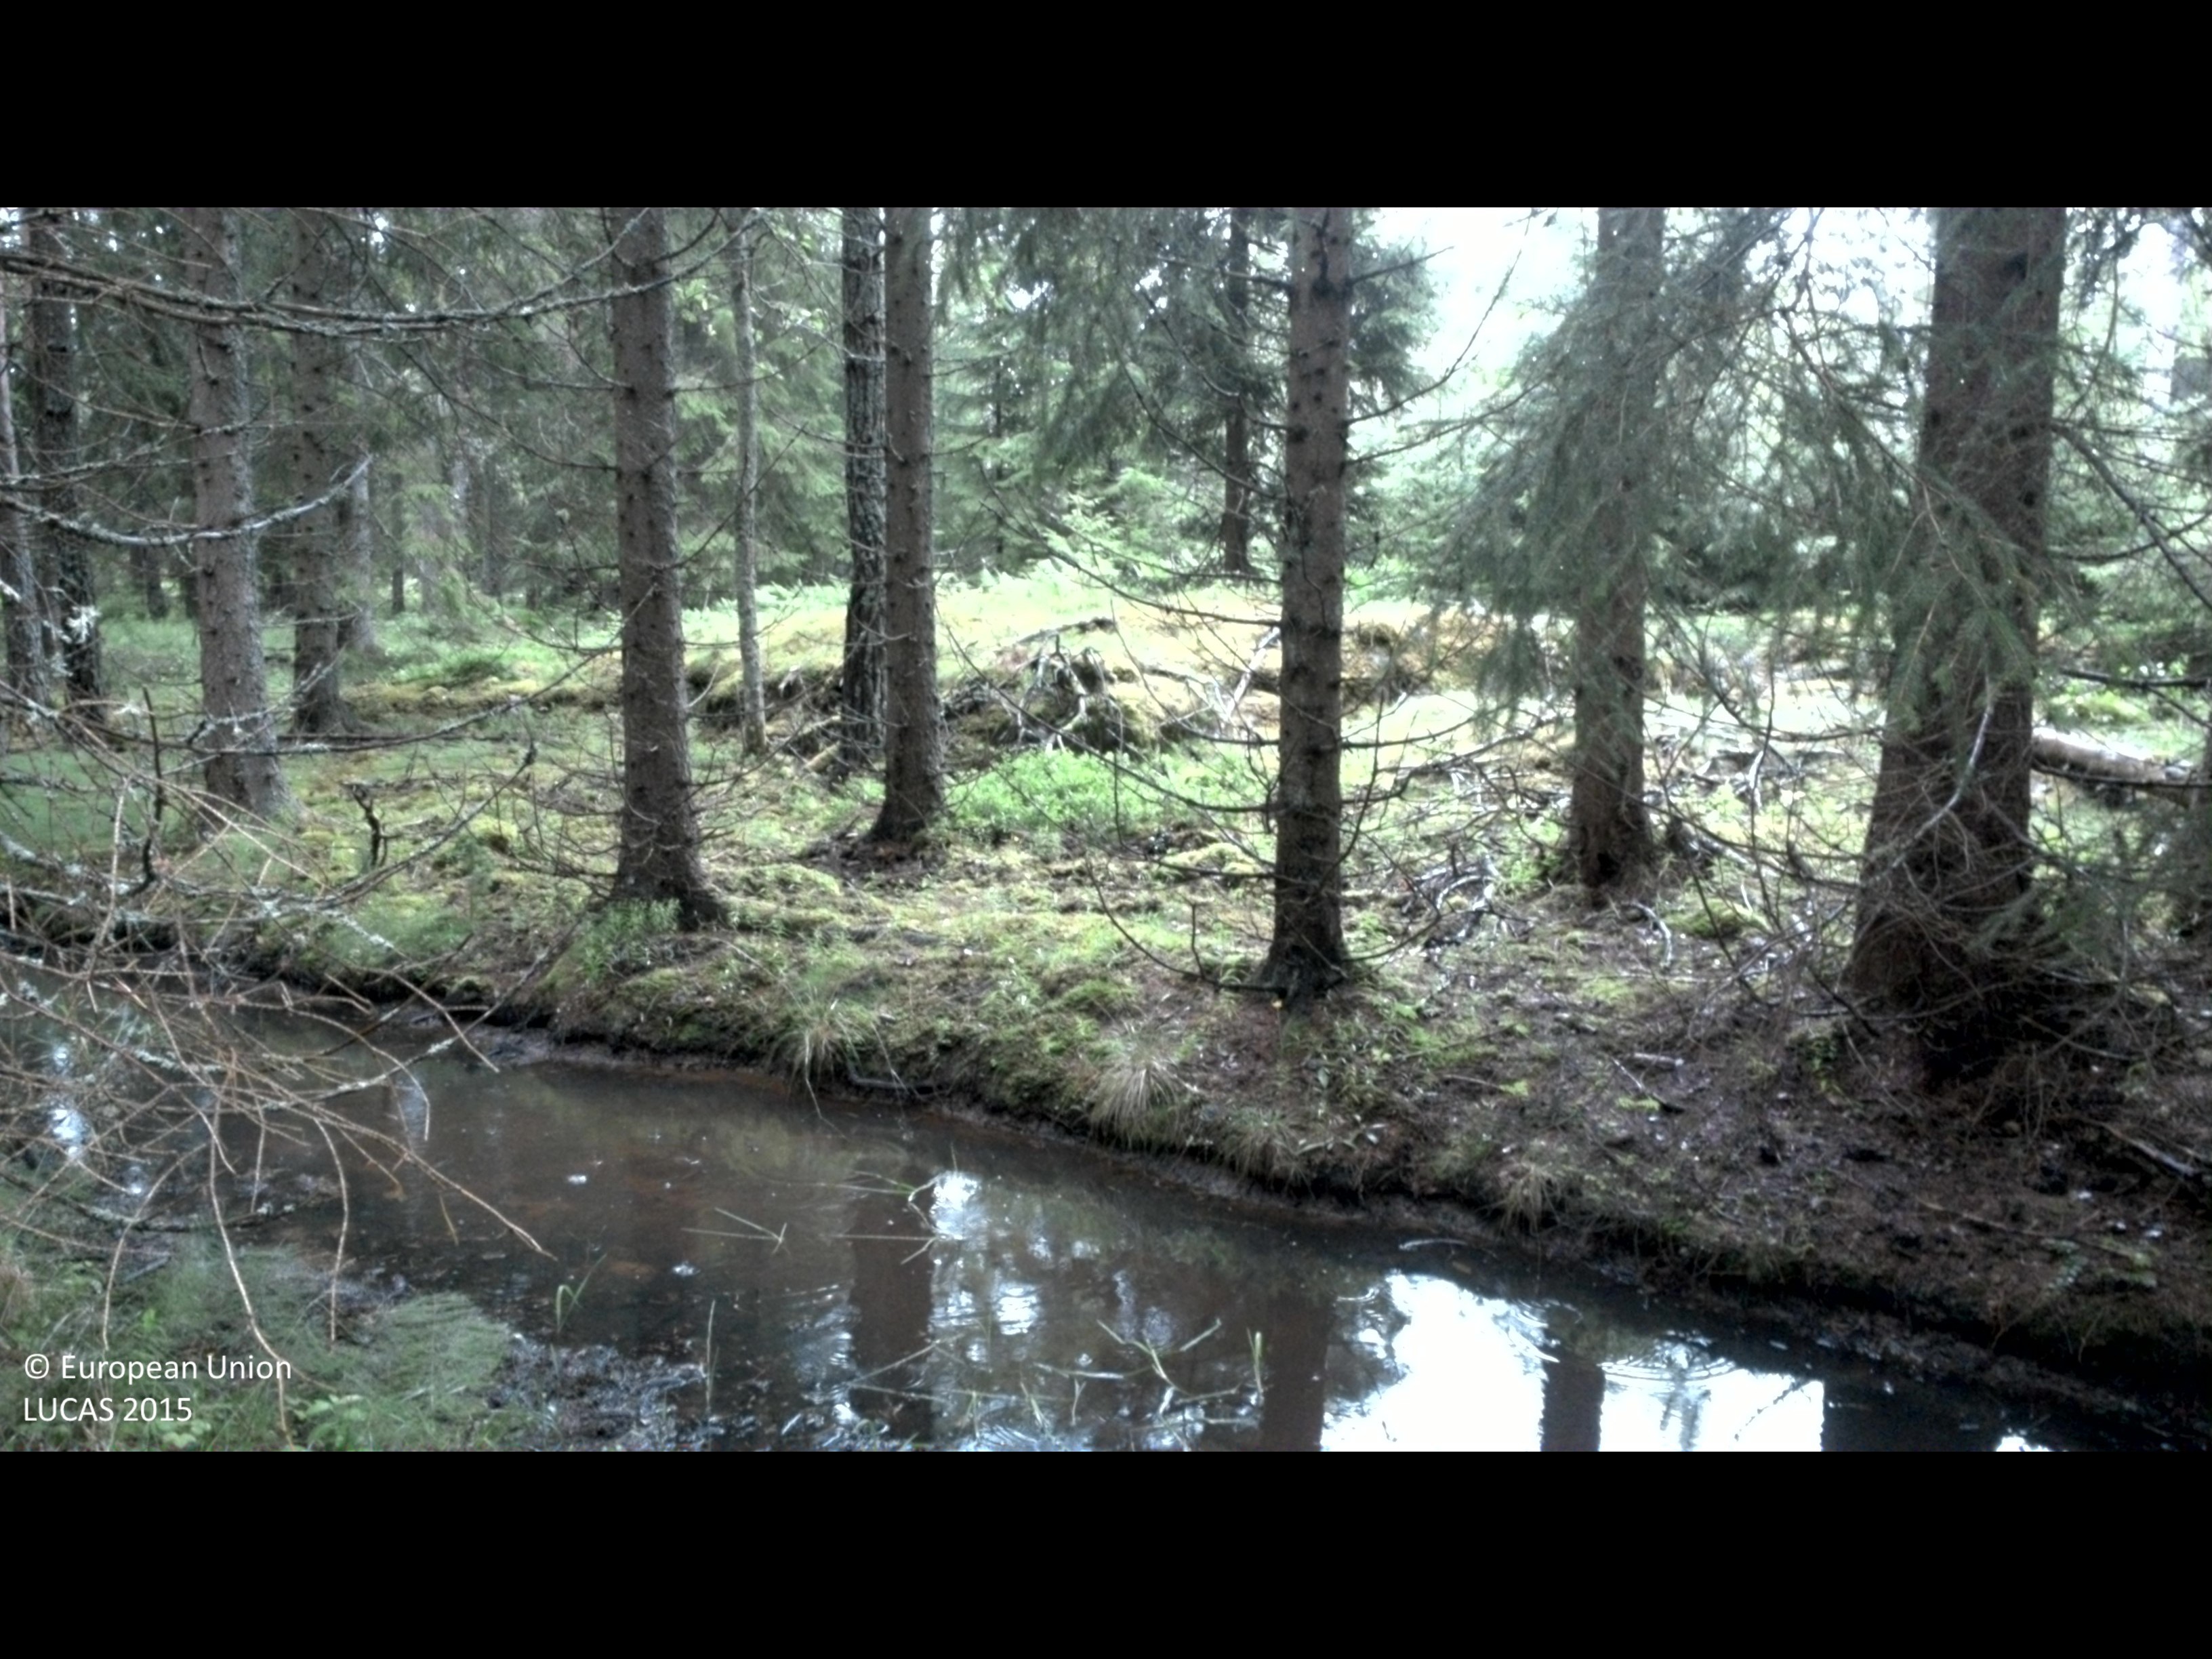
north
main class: Woodland
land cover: Spruce dominated coniferous woodland
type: boreal forest
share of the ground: 50 - 75 %
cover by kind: coniferous forest trees 60 %, herbaceous plants 20 %, lichens and mosses 15 %, shrubs 5 %
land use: Forestry
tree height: > 5 m
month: July
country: SE
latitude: 58.3488
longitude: 16.1638
